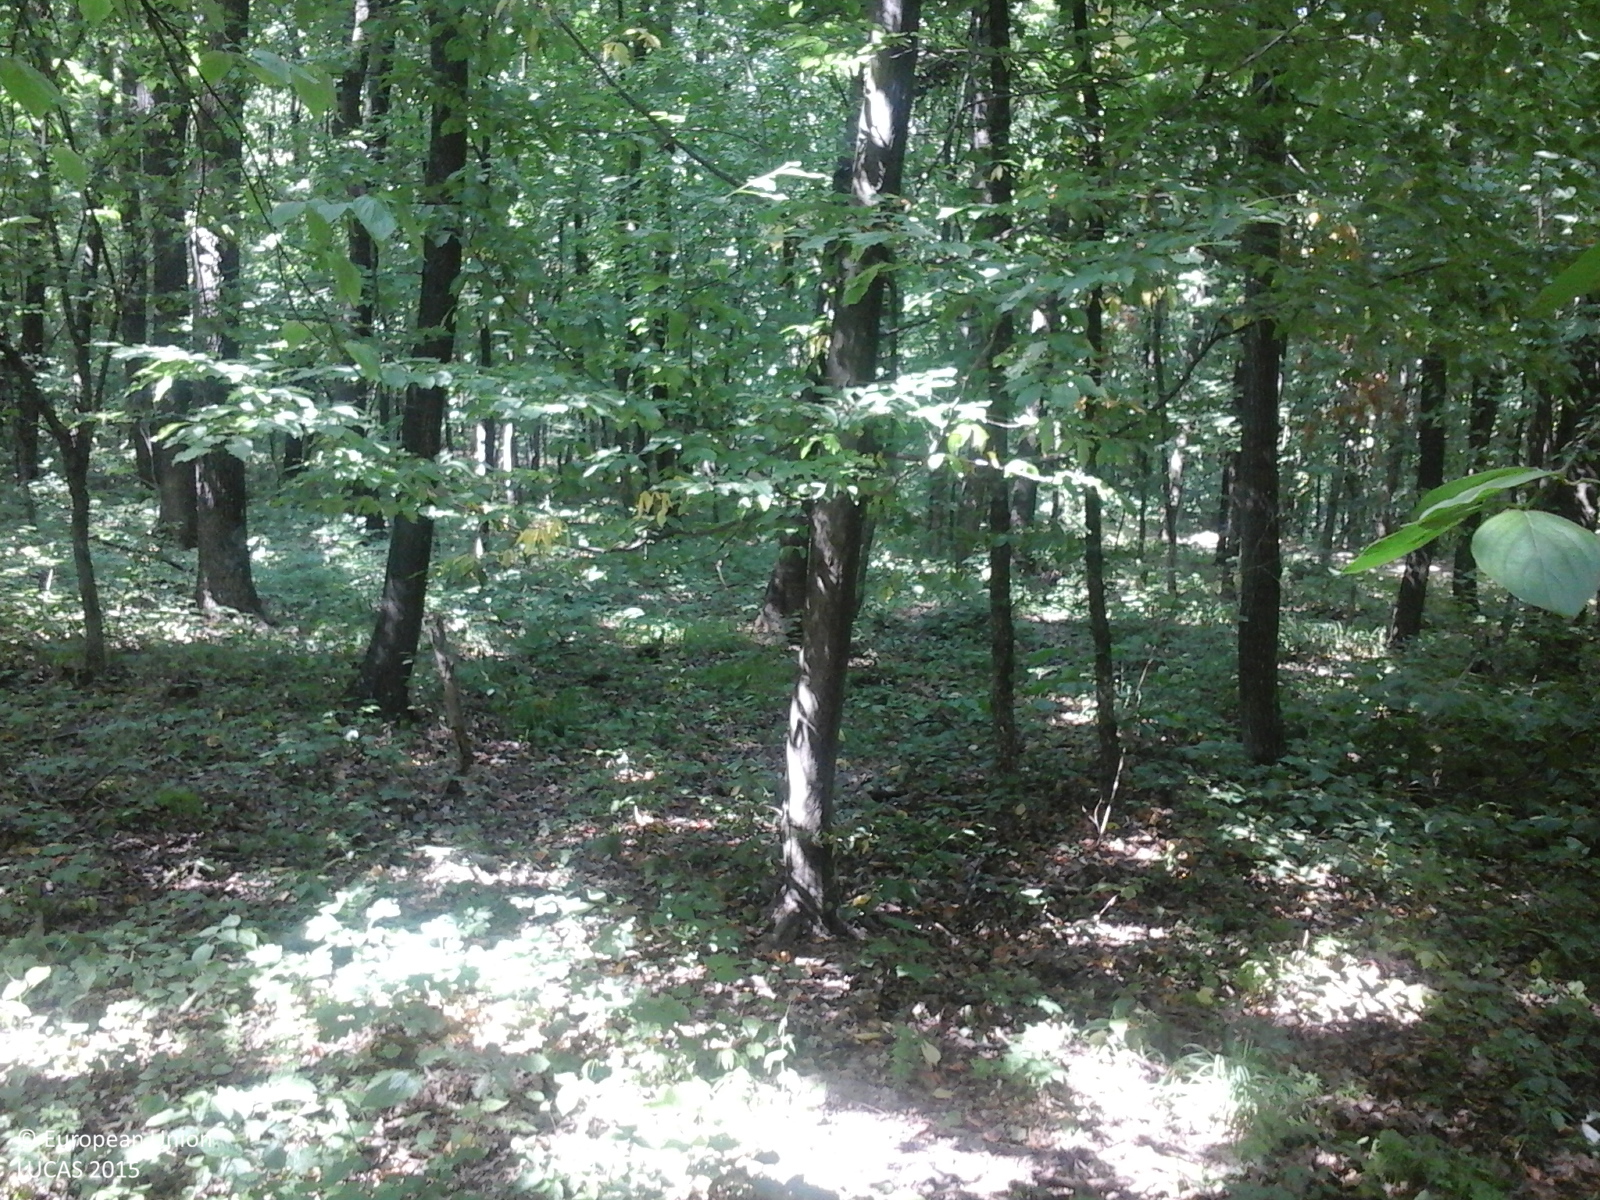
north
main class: Woodland
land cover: Broadleaved woodland
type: beech forest
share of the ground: > 75 %
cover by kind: broadleaved forest trees 90 %, herbaceous plants 10 %
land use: Forestry
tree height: > 5 m
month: June
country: RO
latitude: 46.7271
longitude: 27.9886
